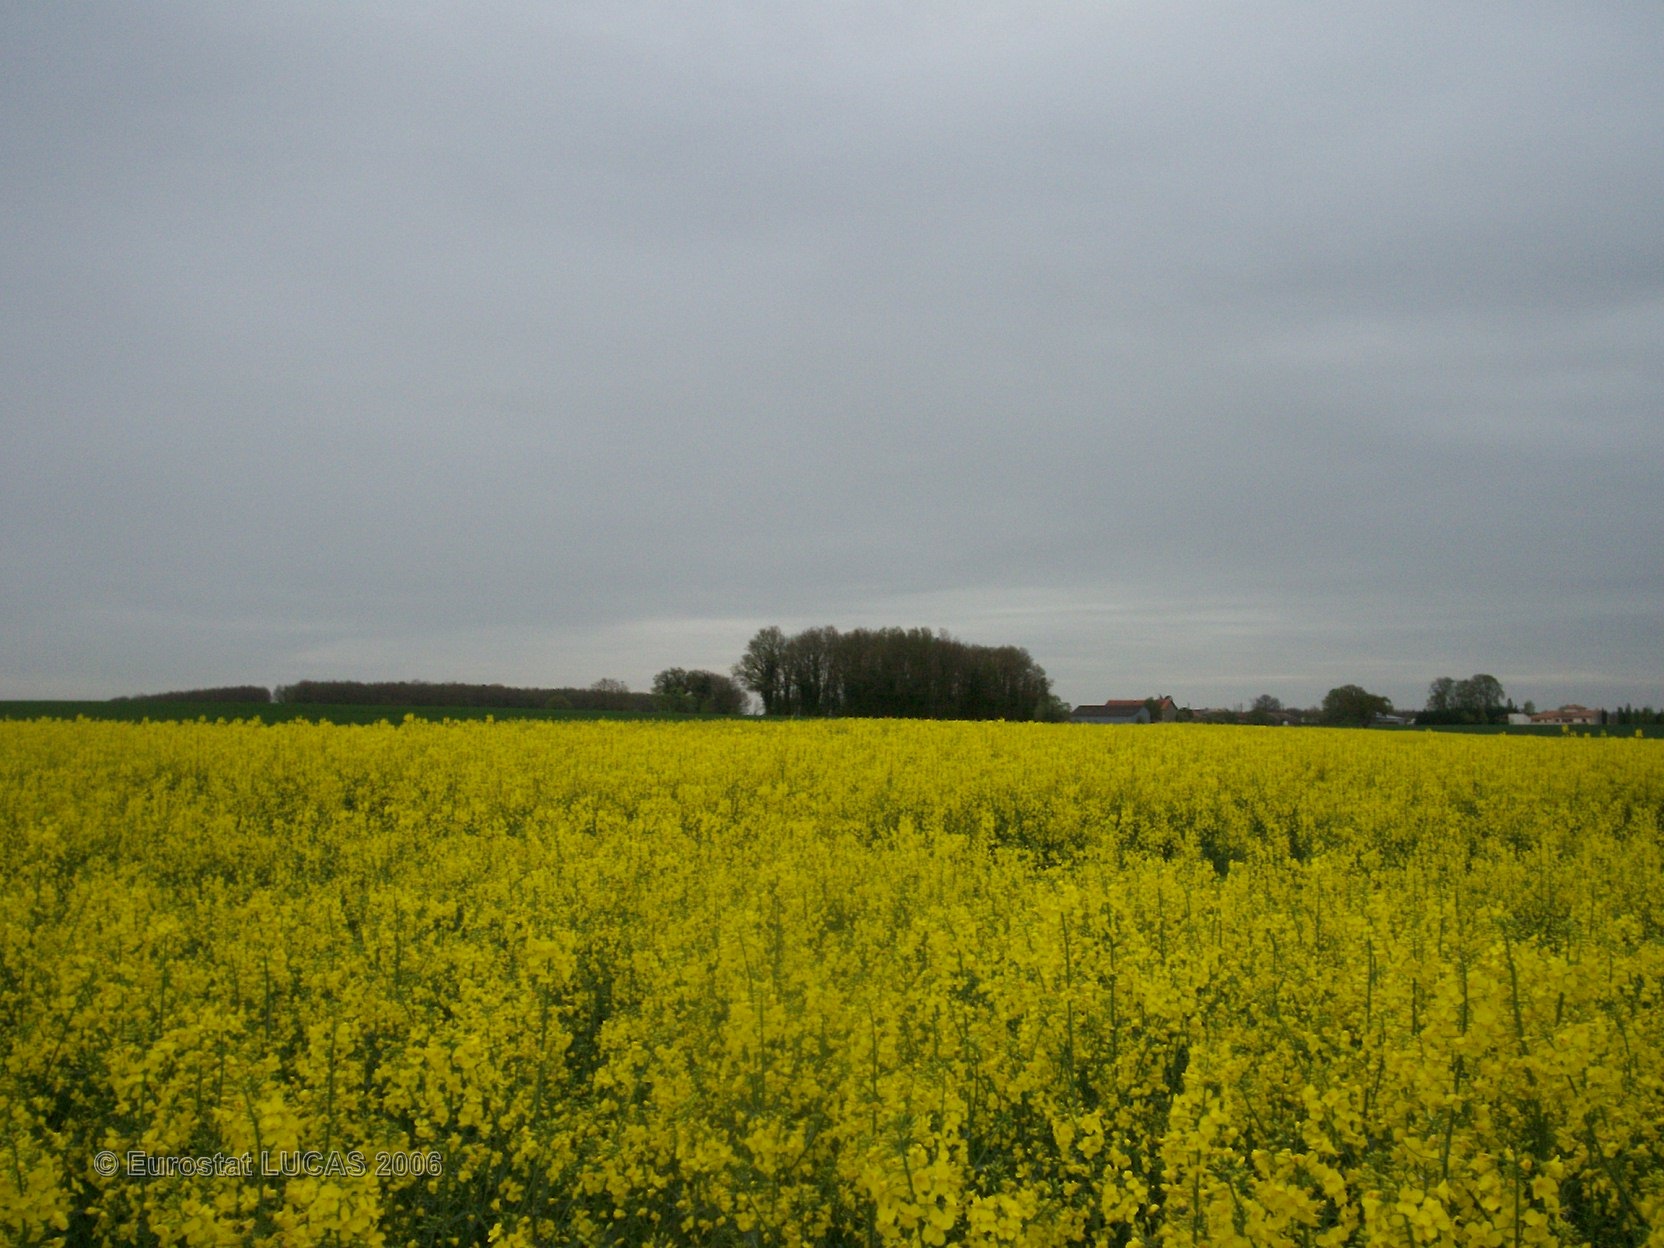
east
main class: Cropland
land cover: Rape and turnip rape
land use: Agriculture (excluding fallow land and kitchen gardens)
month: April
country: FR
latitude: 46.5509
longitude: 0.5794
